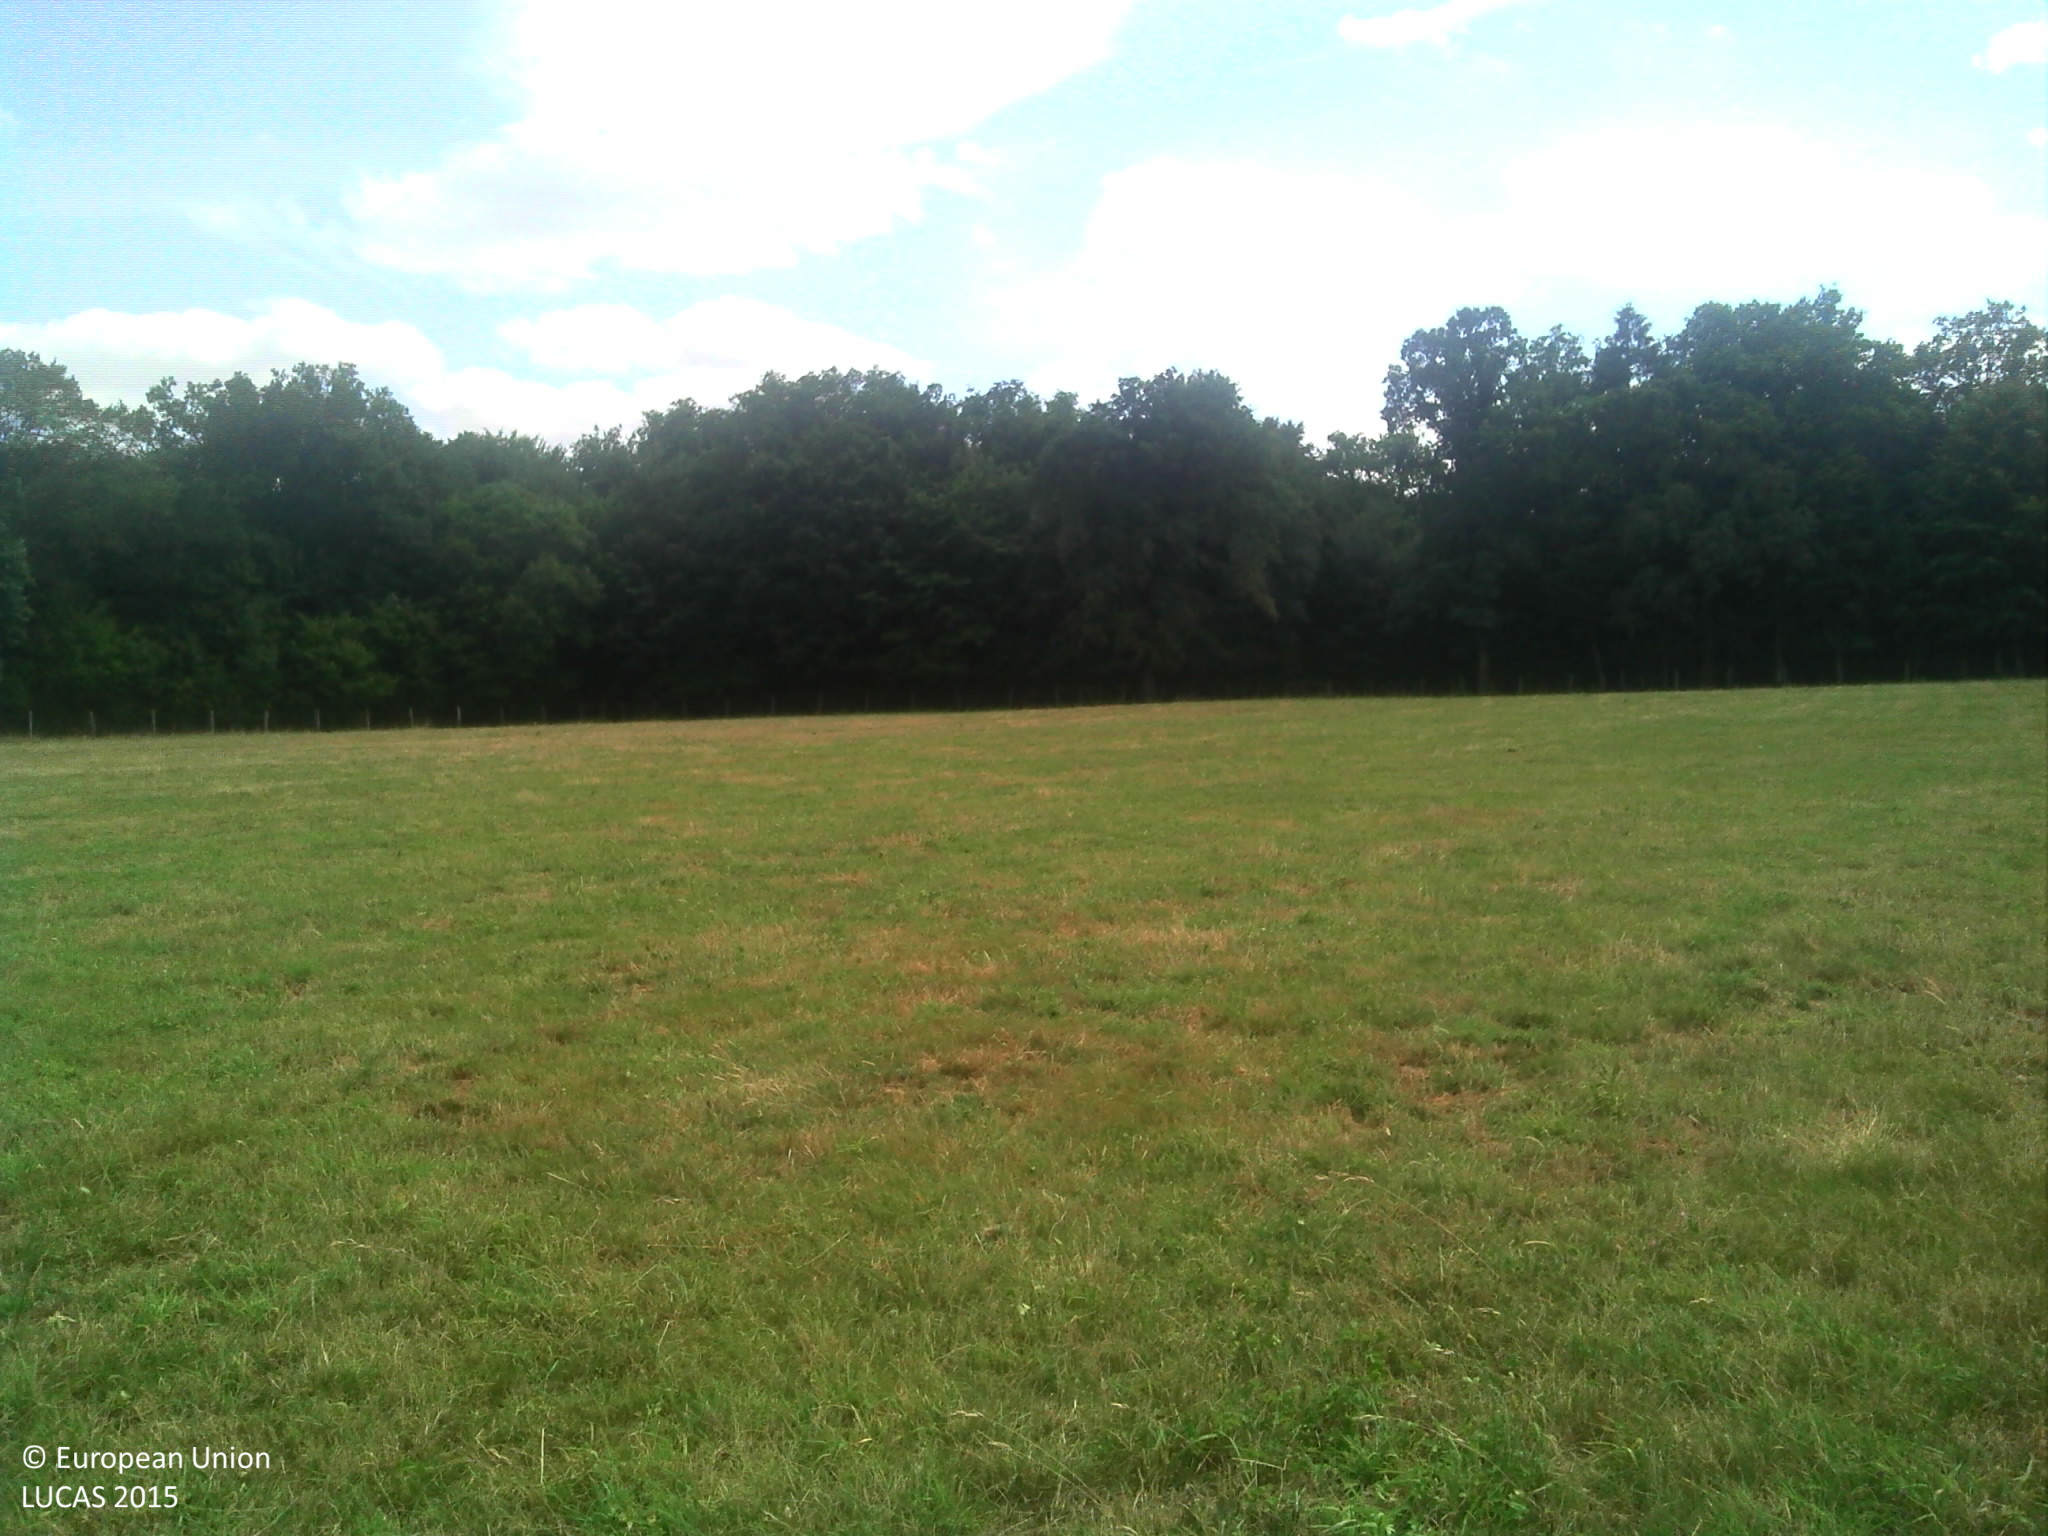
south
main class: Grassland
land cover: Grassland without tree/shrub cover
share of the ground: > 75 %
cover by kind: herbaceous plants 100 %
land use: Agriculture (excluding fallow land and kitchen gardens)
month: July
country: FR
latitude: 48.0965
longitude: 5.0981
